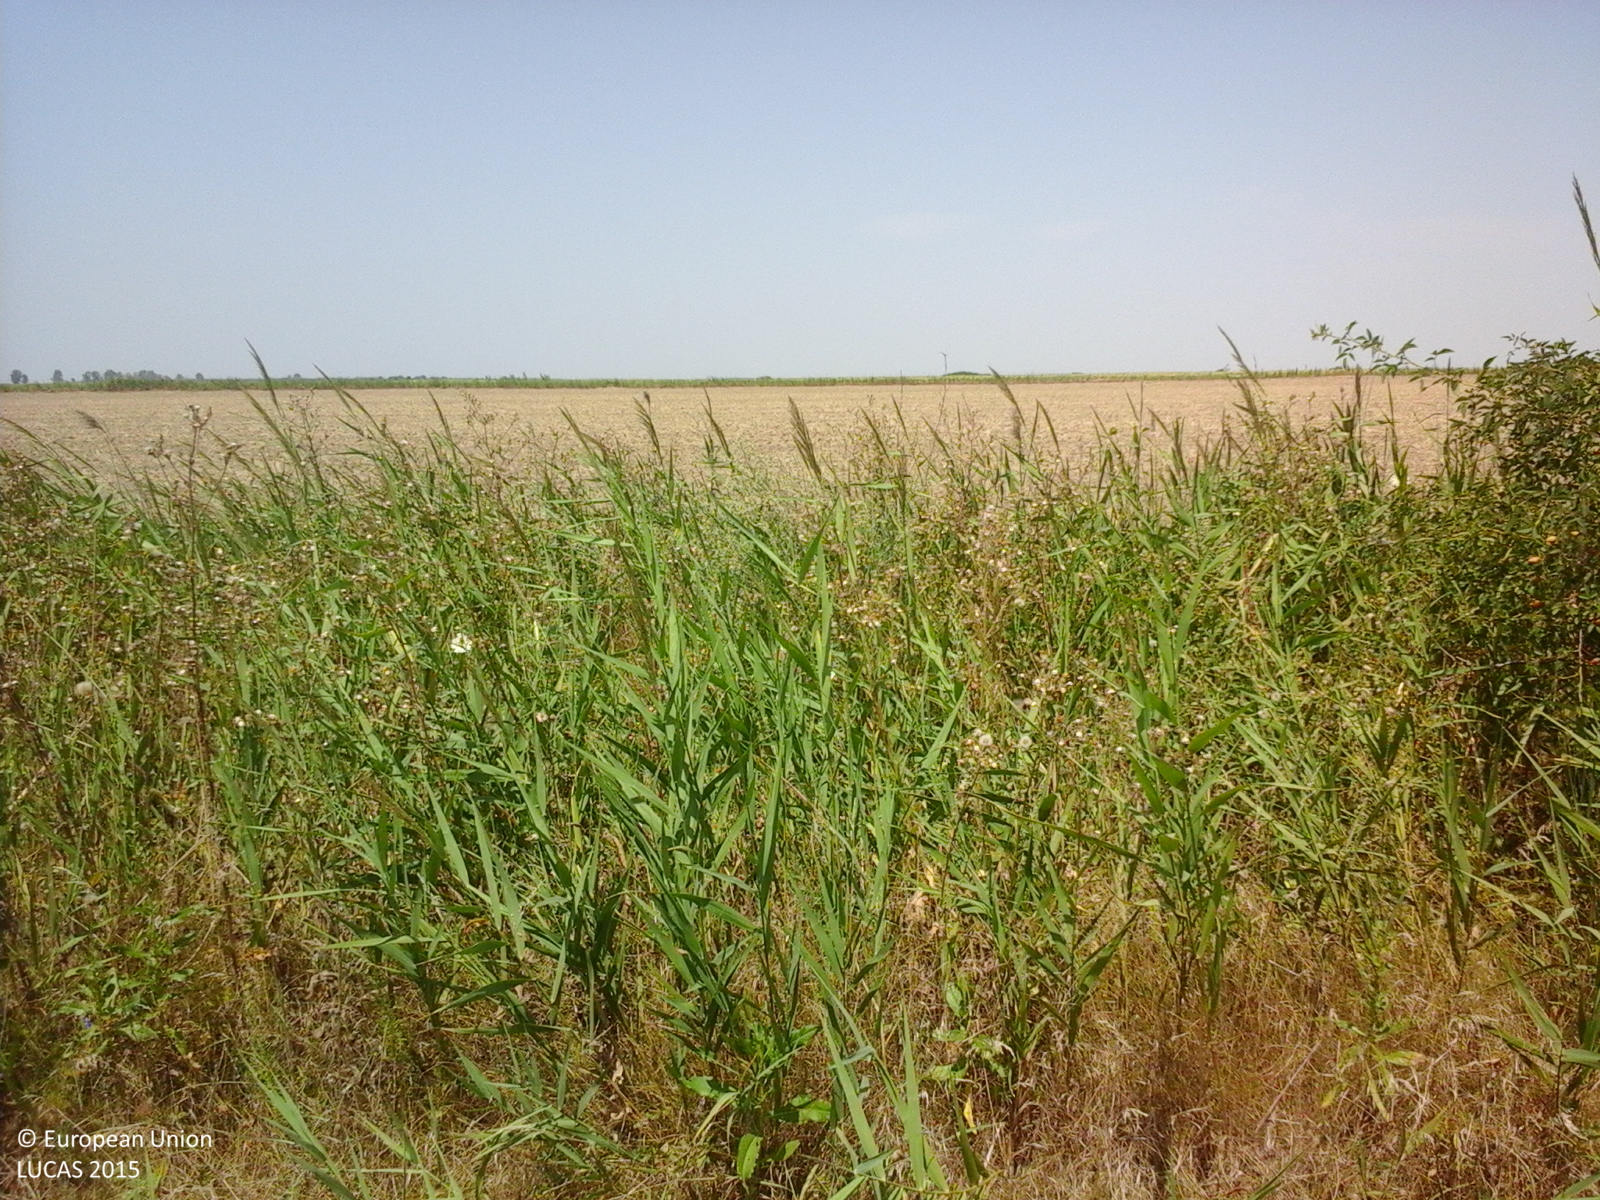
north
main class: Cropland
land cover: Sunflower
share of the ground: > 75 %
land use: Agriculture (excluding fallow land and kitchen gardens)
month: August
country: RO
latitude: 45.3121
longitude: 27.7487
